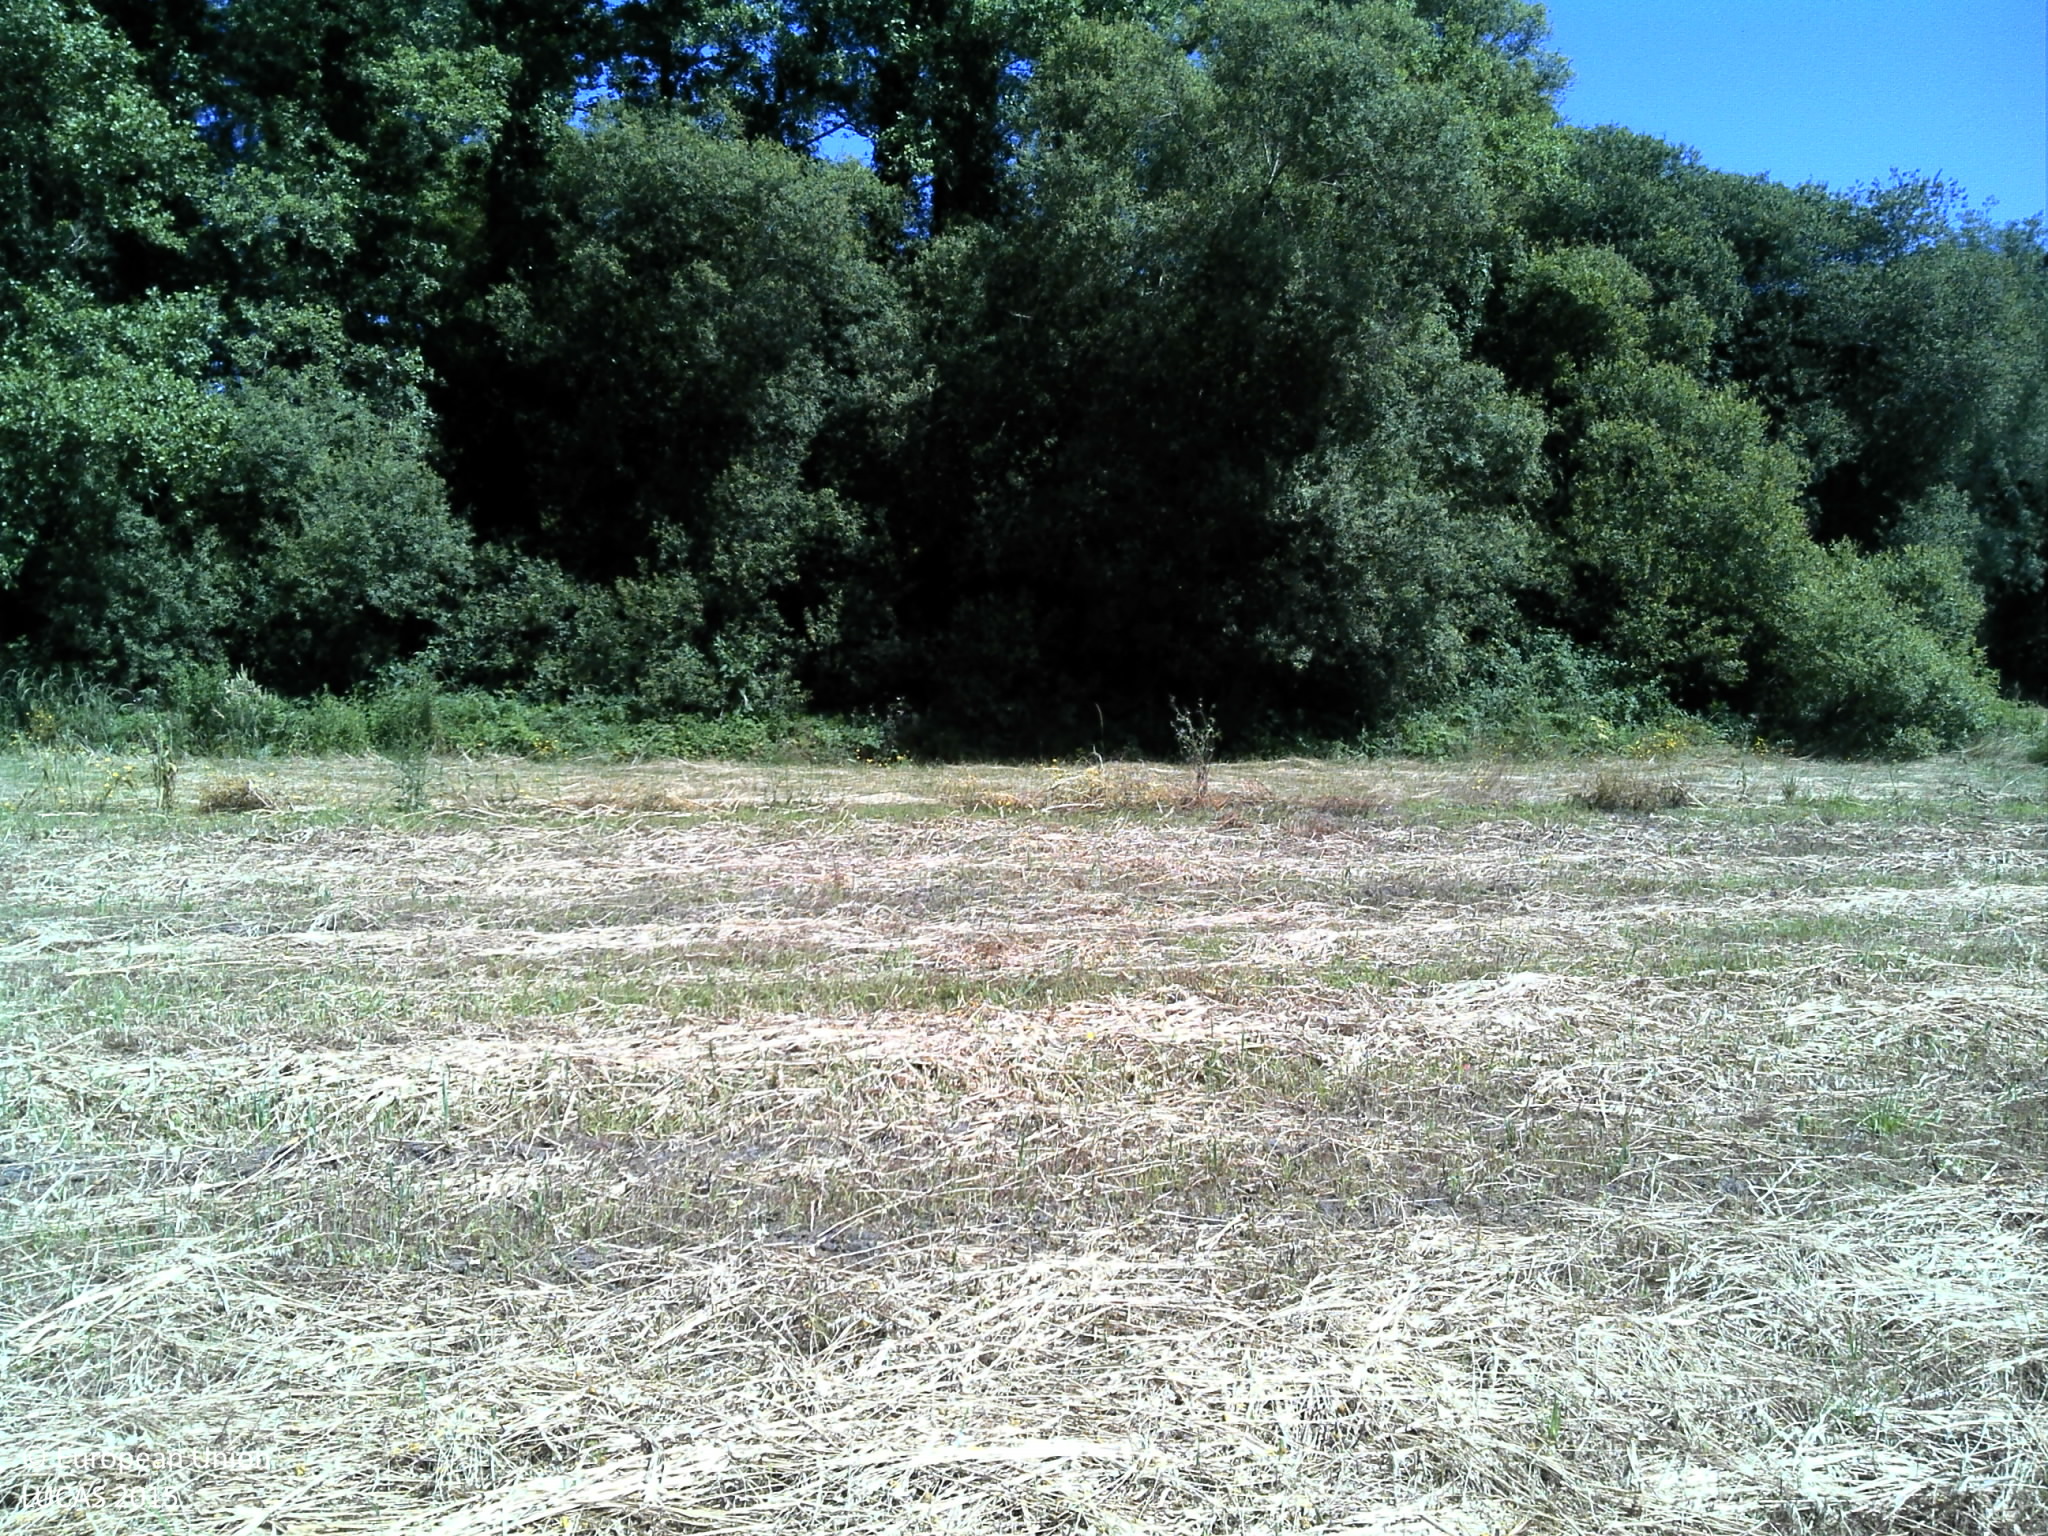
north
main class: Grassland
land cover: Spontaneously vegetated surfaces
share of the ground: < 10 %
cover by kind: unconsolidated bare surface 90 %, herbaceous plants 10 %
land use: Agriculture (excluding fallow land and kitchen gardens)
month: May
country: PT
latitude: 41.7278
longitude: -8.6902
